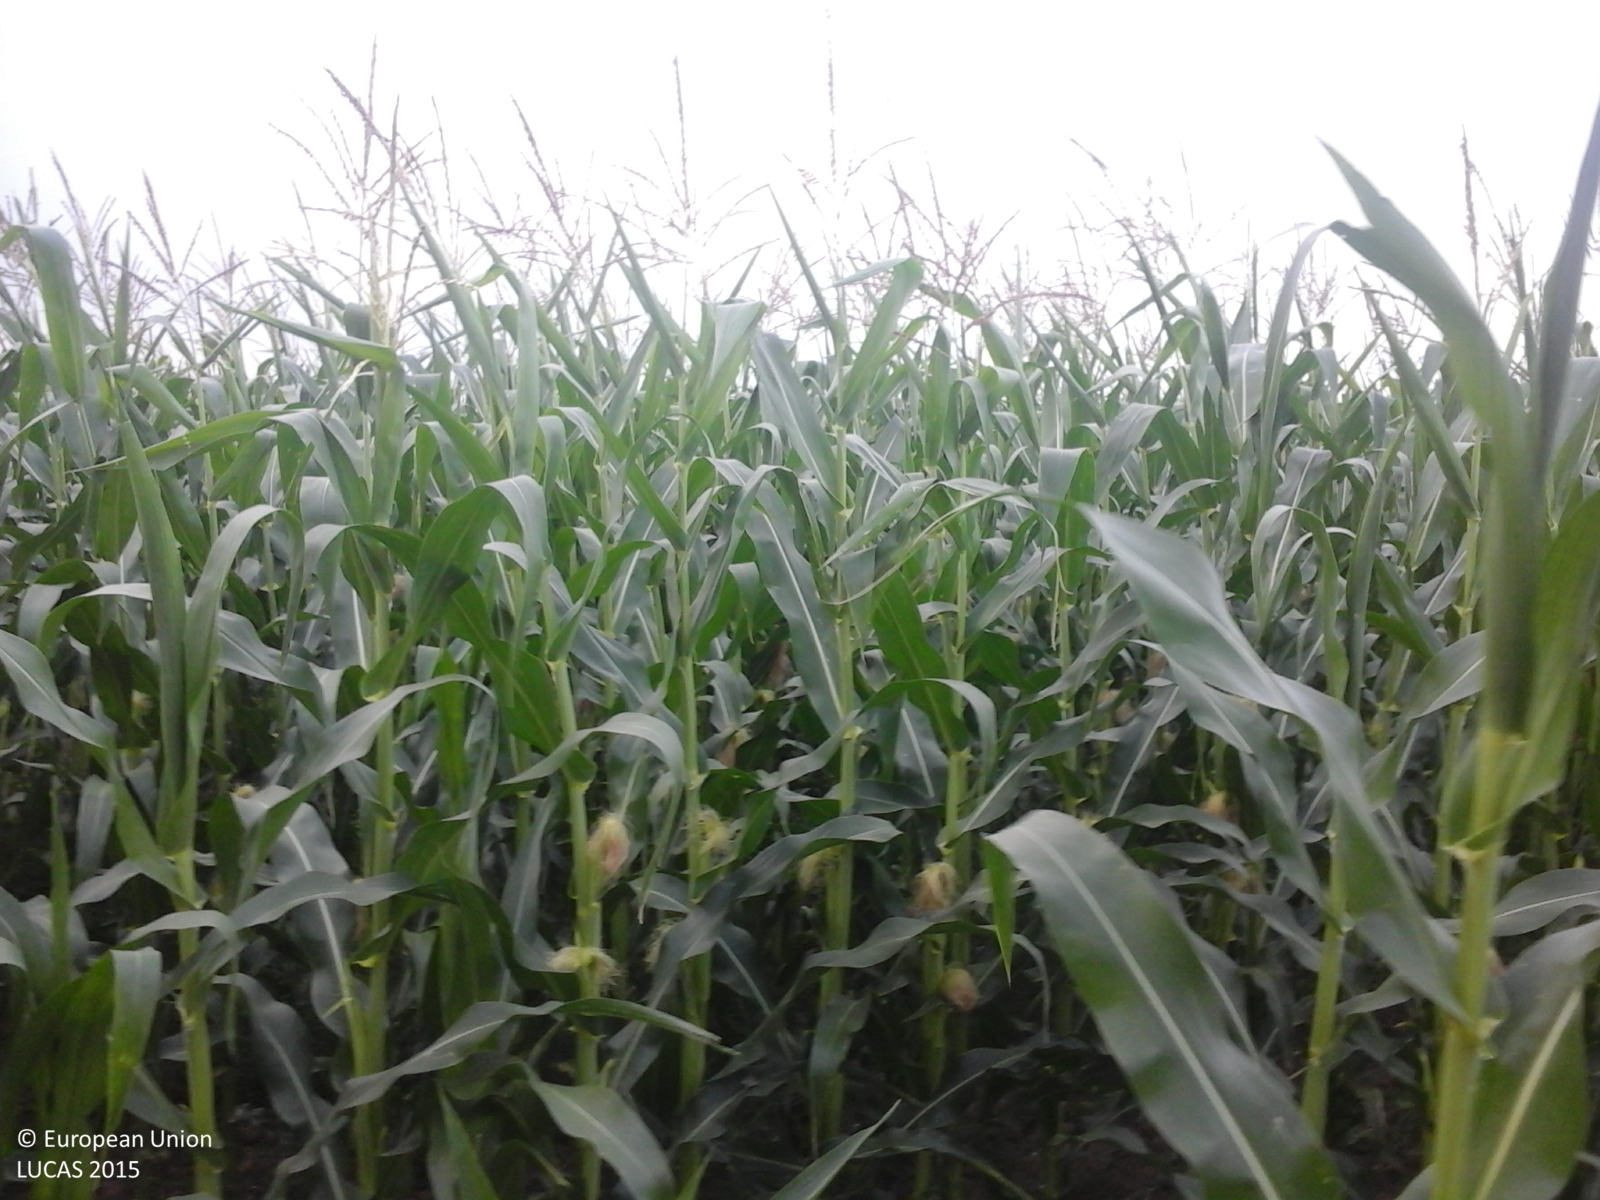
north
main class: Cropland
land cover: Maize
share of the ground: > 75 %
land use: Agriculture (excluding fallow land and kitchen gardens)
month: July
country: RO
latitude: 43.8696
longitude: 24.6648
